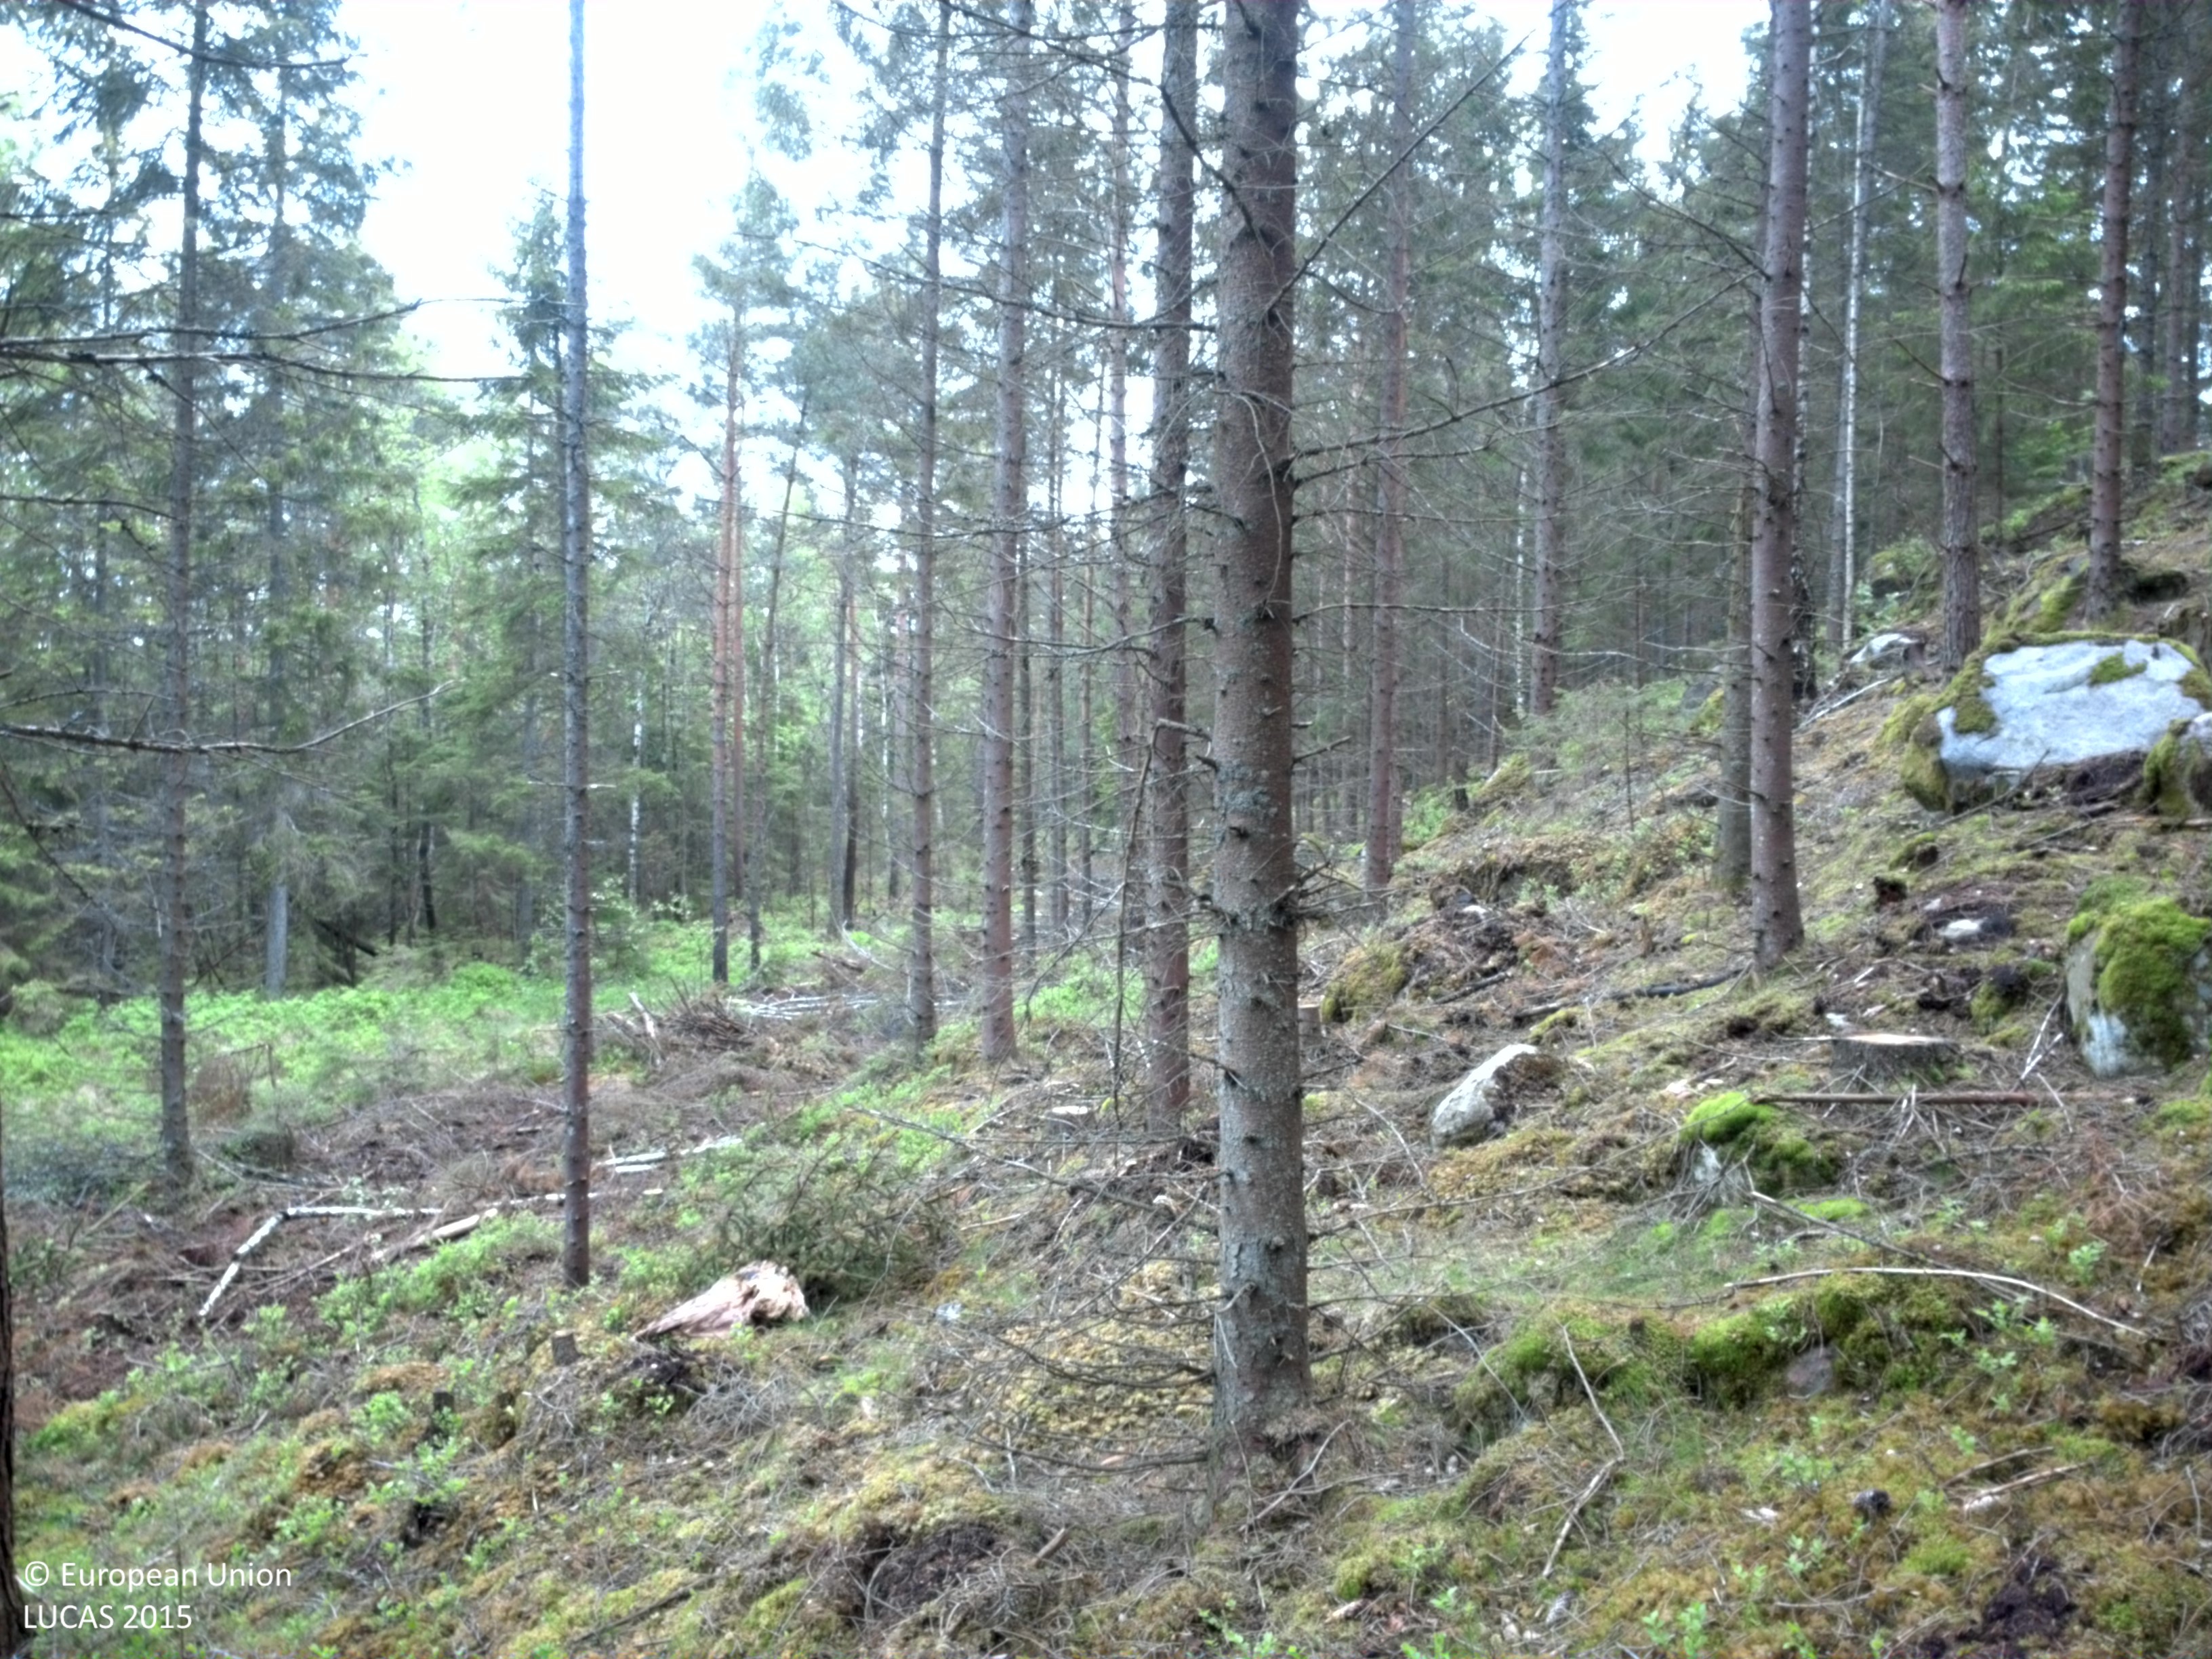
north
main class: Woodland
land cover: Spruce dominated coniferous woodland
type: boreal forest
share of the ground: 50 - 75 %
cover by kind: coniferous forest trees 50 %, shrubs 25 %, lichens and mosses 15 %, broadleaved forest trees 5 %, herbaceous plants 5 %
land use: Forestry
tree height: > 5 m
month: June
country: SE
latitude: 56.7640
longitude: 14.2994
